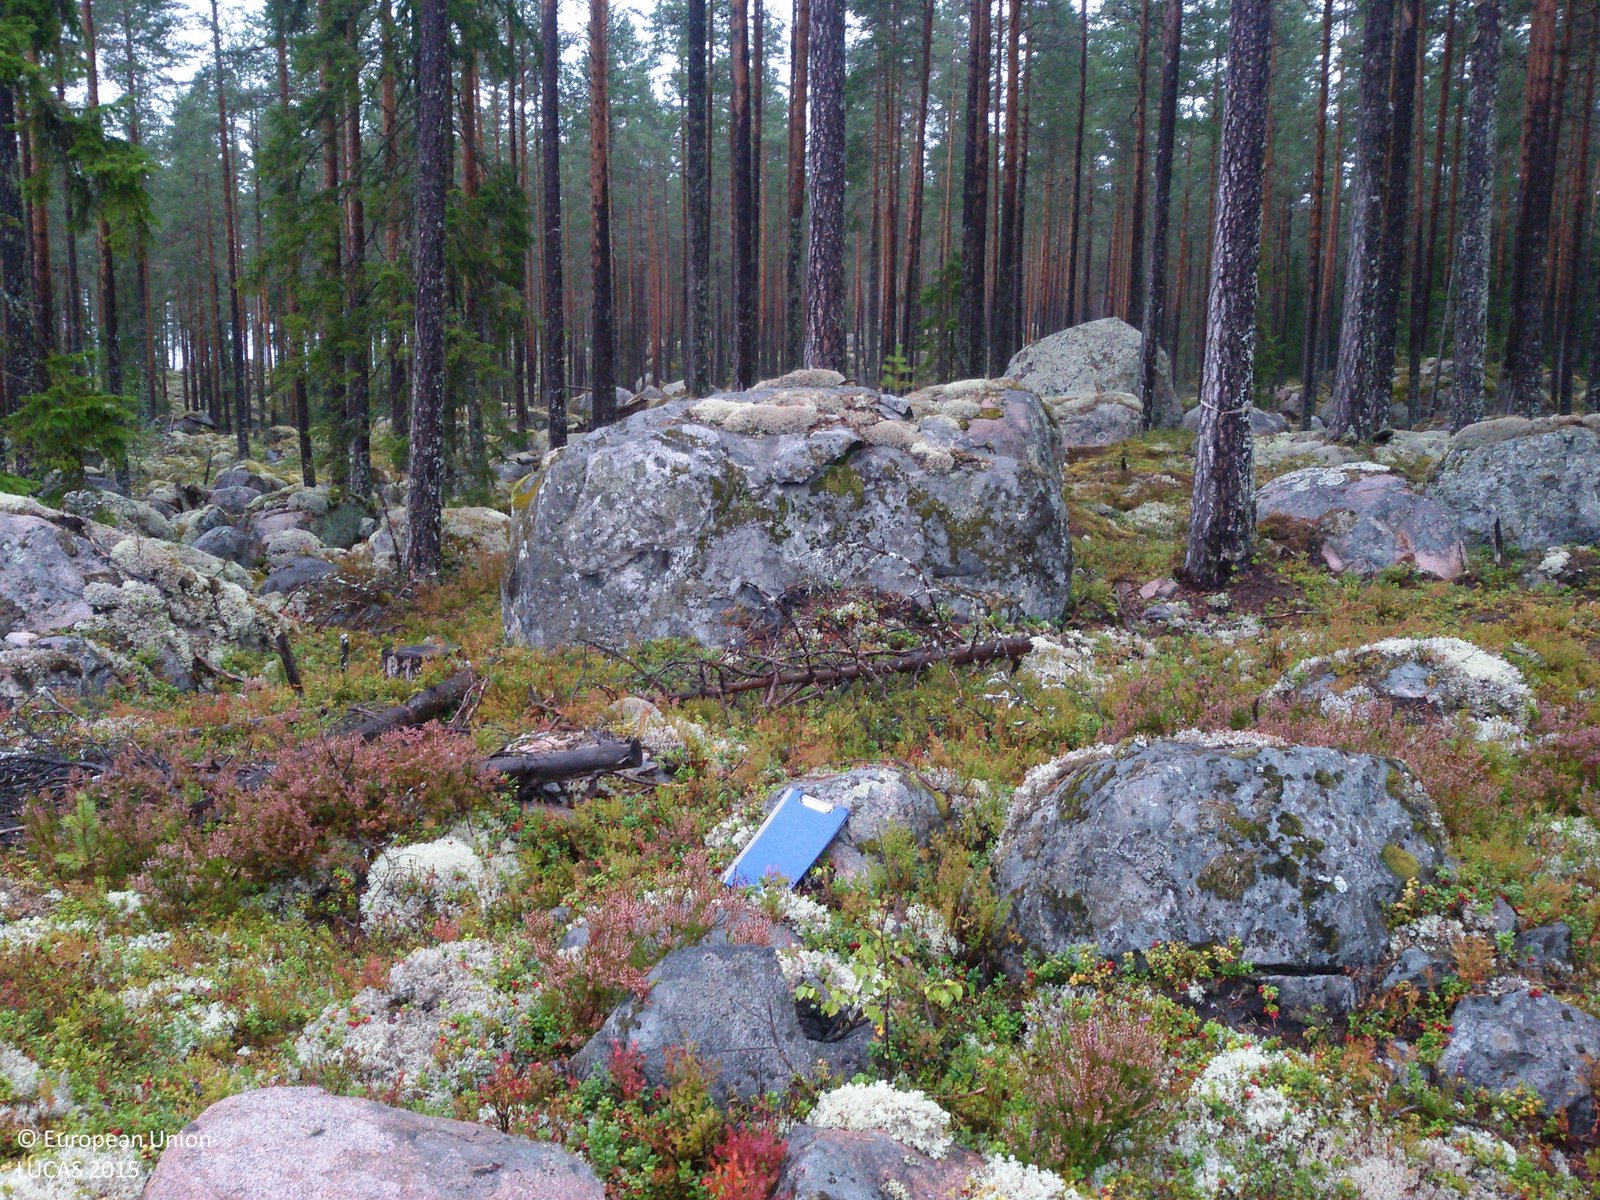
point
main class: Woodland
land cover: Pine dominated coniferous woodland
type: boreal forest
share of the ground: 10 - 25 %
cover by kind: herbaceous plants 40 %, lichens and mosses 40 %, coniferous forest trees 15 %, broadleaved forest trees 5 %
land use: Forestry
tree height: < 5 m
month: September
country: SE
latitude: 60.9836
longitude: 15.7706
